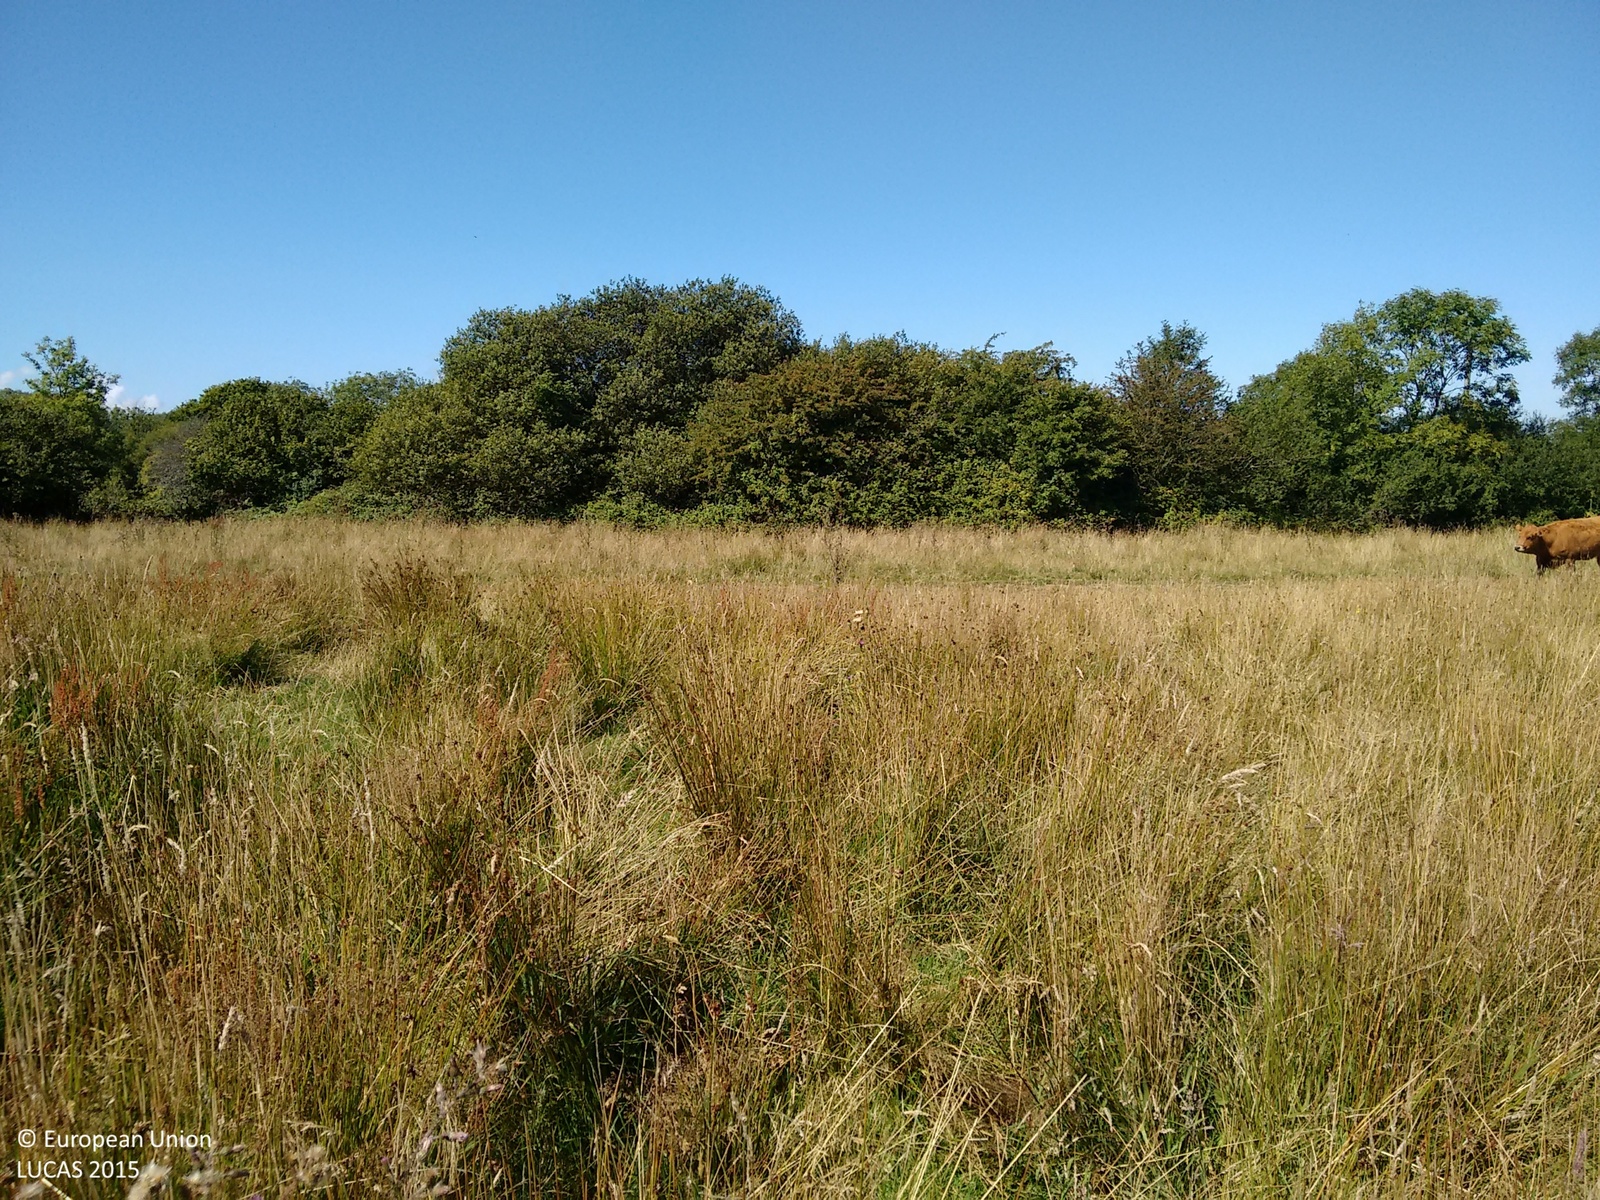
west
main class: Grassland
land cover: Grassland without tree/shrub cover
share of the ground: > 75 %
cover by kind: herbaceous plants 100 %
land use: Agriculture (excluding fallow land and kitchen gardens)
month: August
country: GB
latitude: 51.7129
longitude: -4.8323
